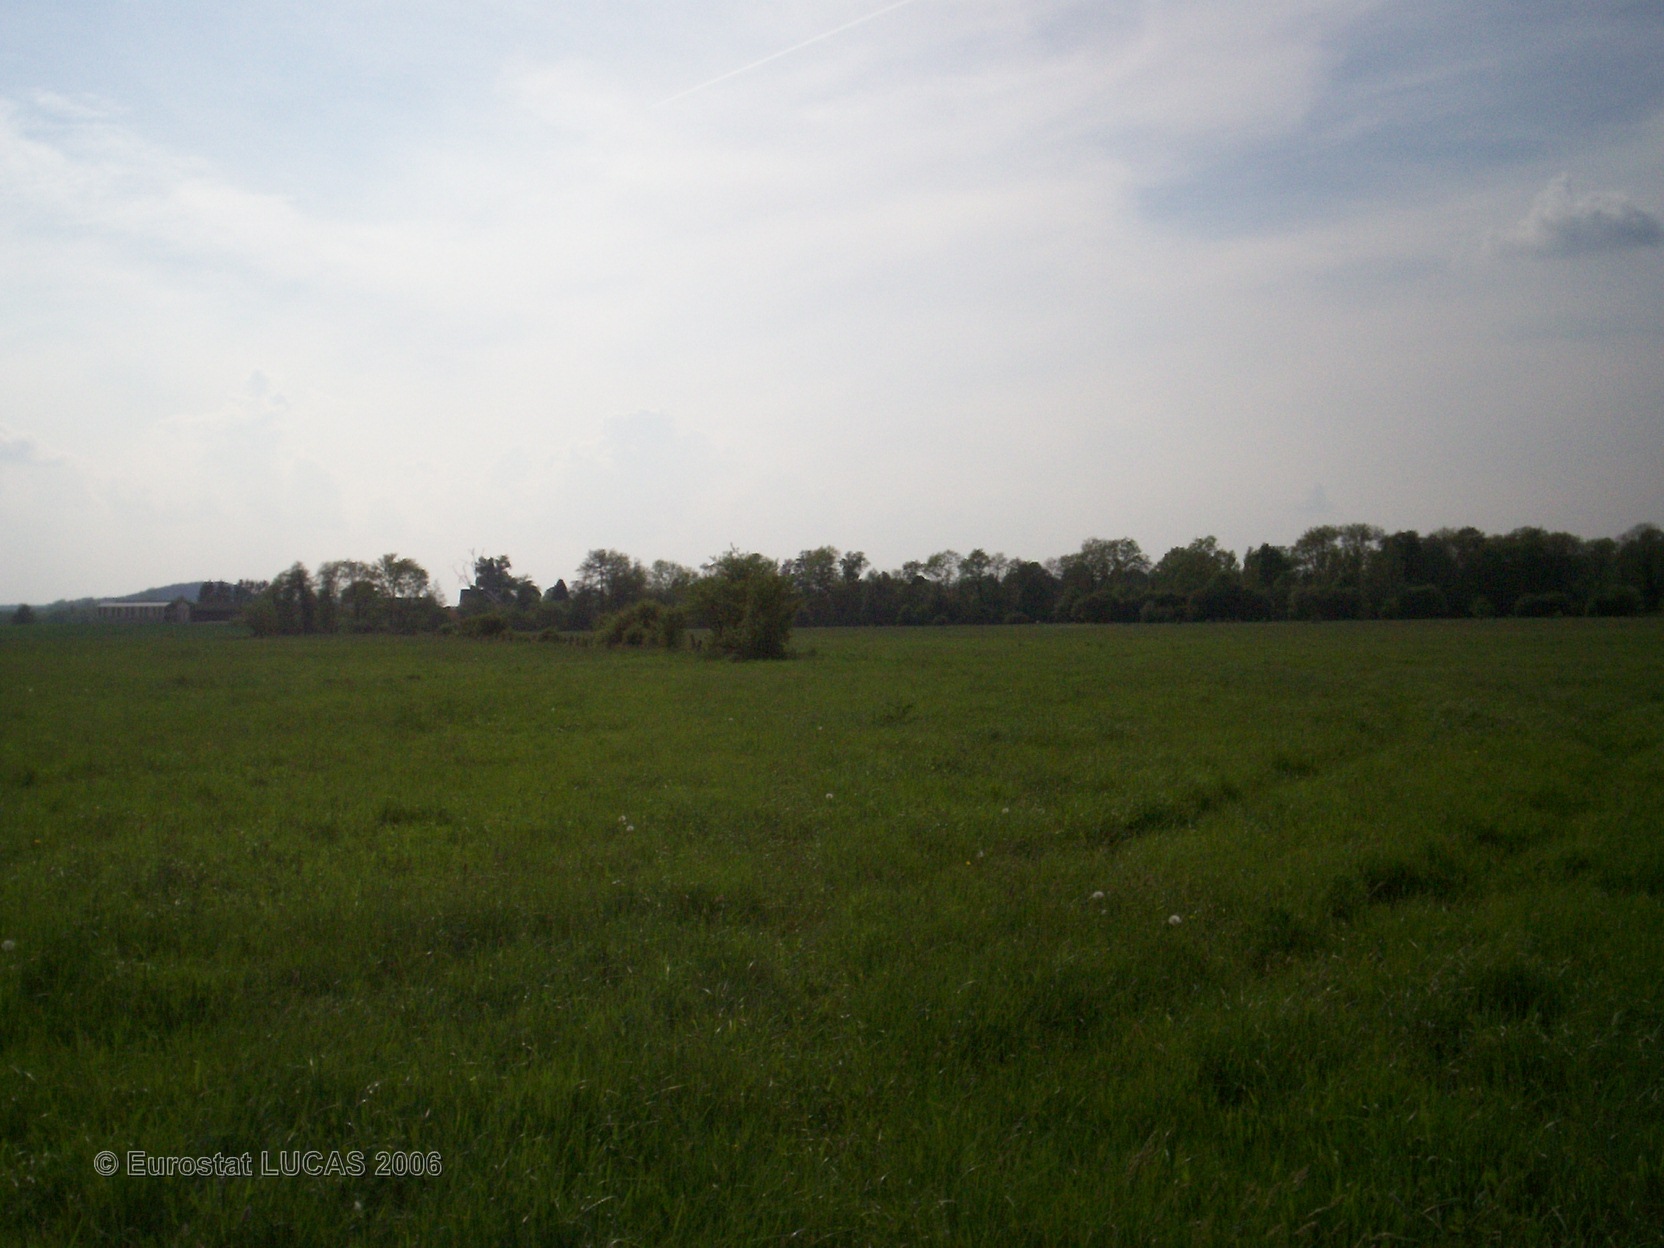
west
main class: Grassland
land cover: Grassland without tree/shrub cover
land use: Agriculture (excluding fallow land and kitchen gardens)
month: May
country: FR
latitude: 49.6108
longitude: 4.3354
